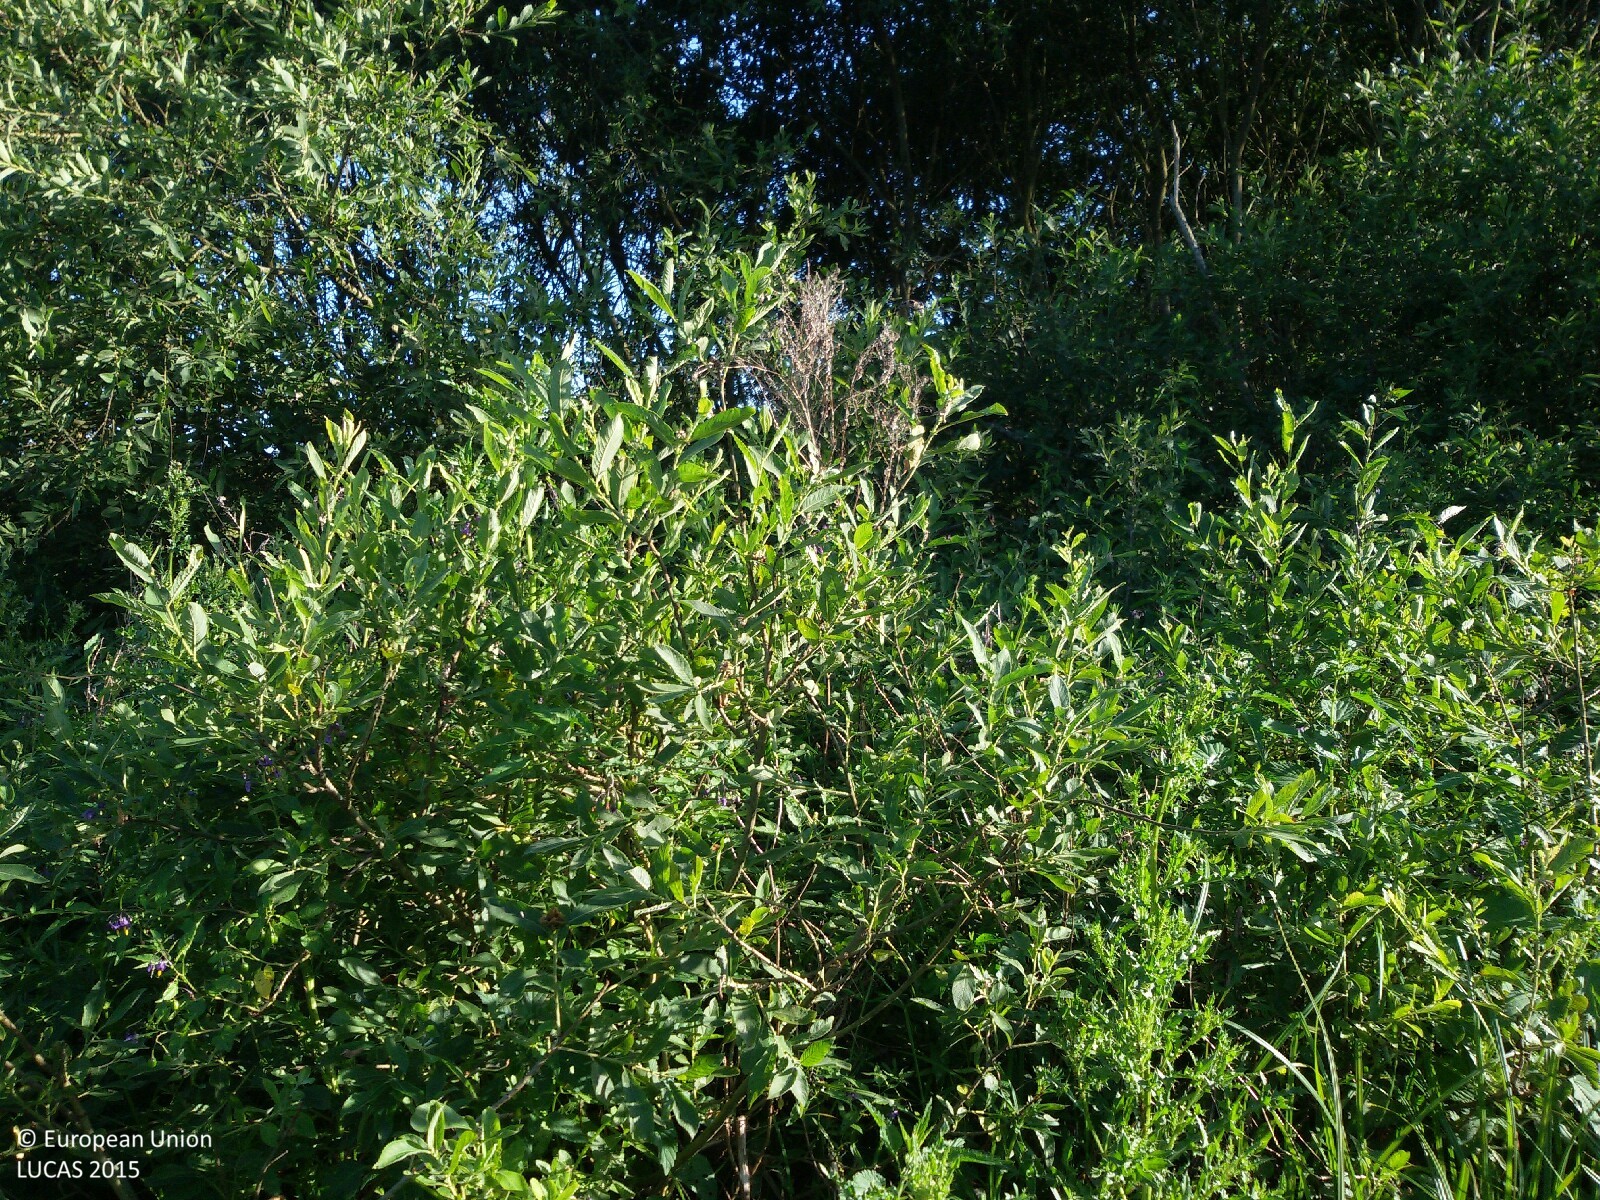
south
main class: Shrubland
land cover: Shrubland without tree cover
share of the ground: 50 - 75 %
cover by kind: shrubs 50 %, herbaceous plants 50 %
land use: Semi-natural and natural areas not in use
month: July
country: PL
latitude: 54.0153
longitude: 20.2742
